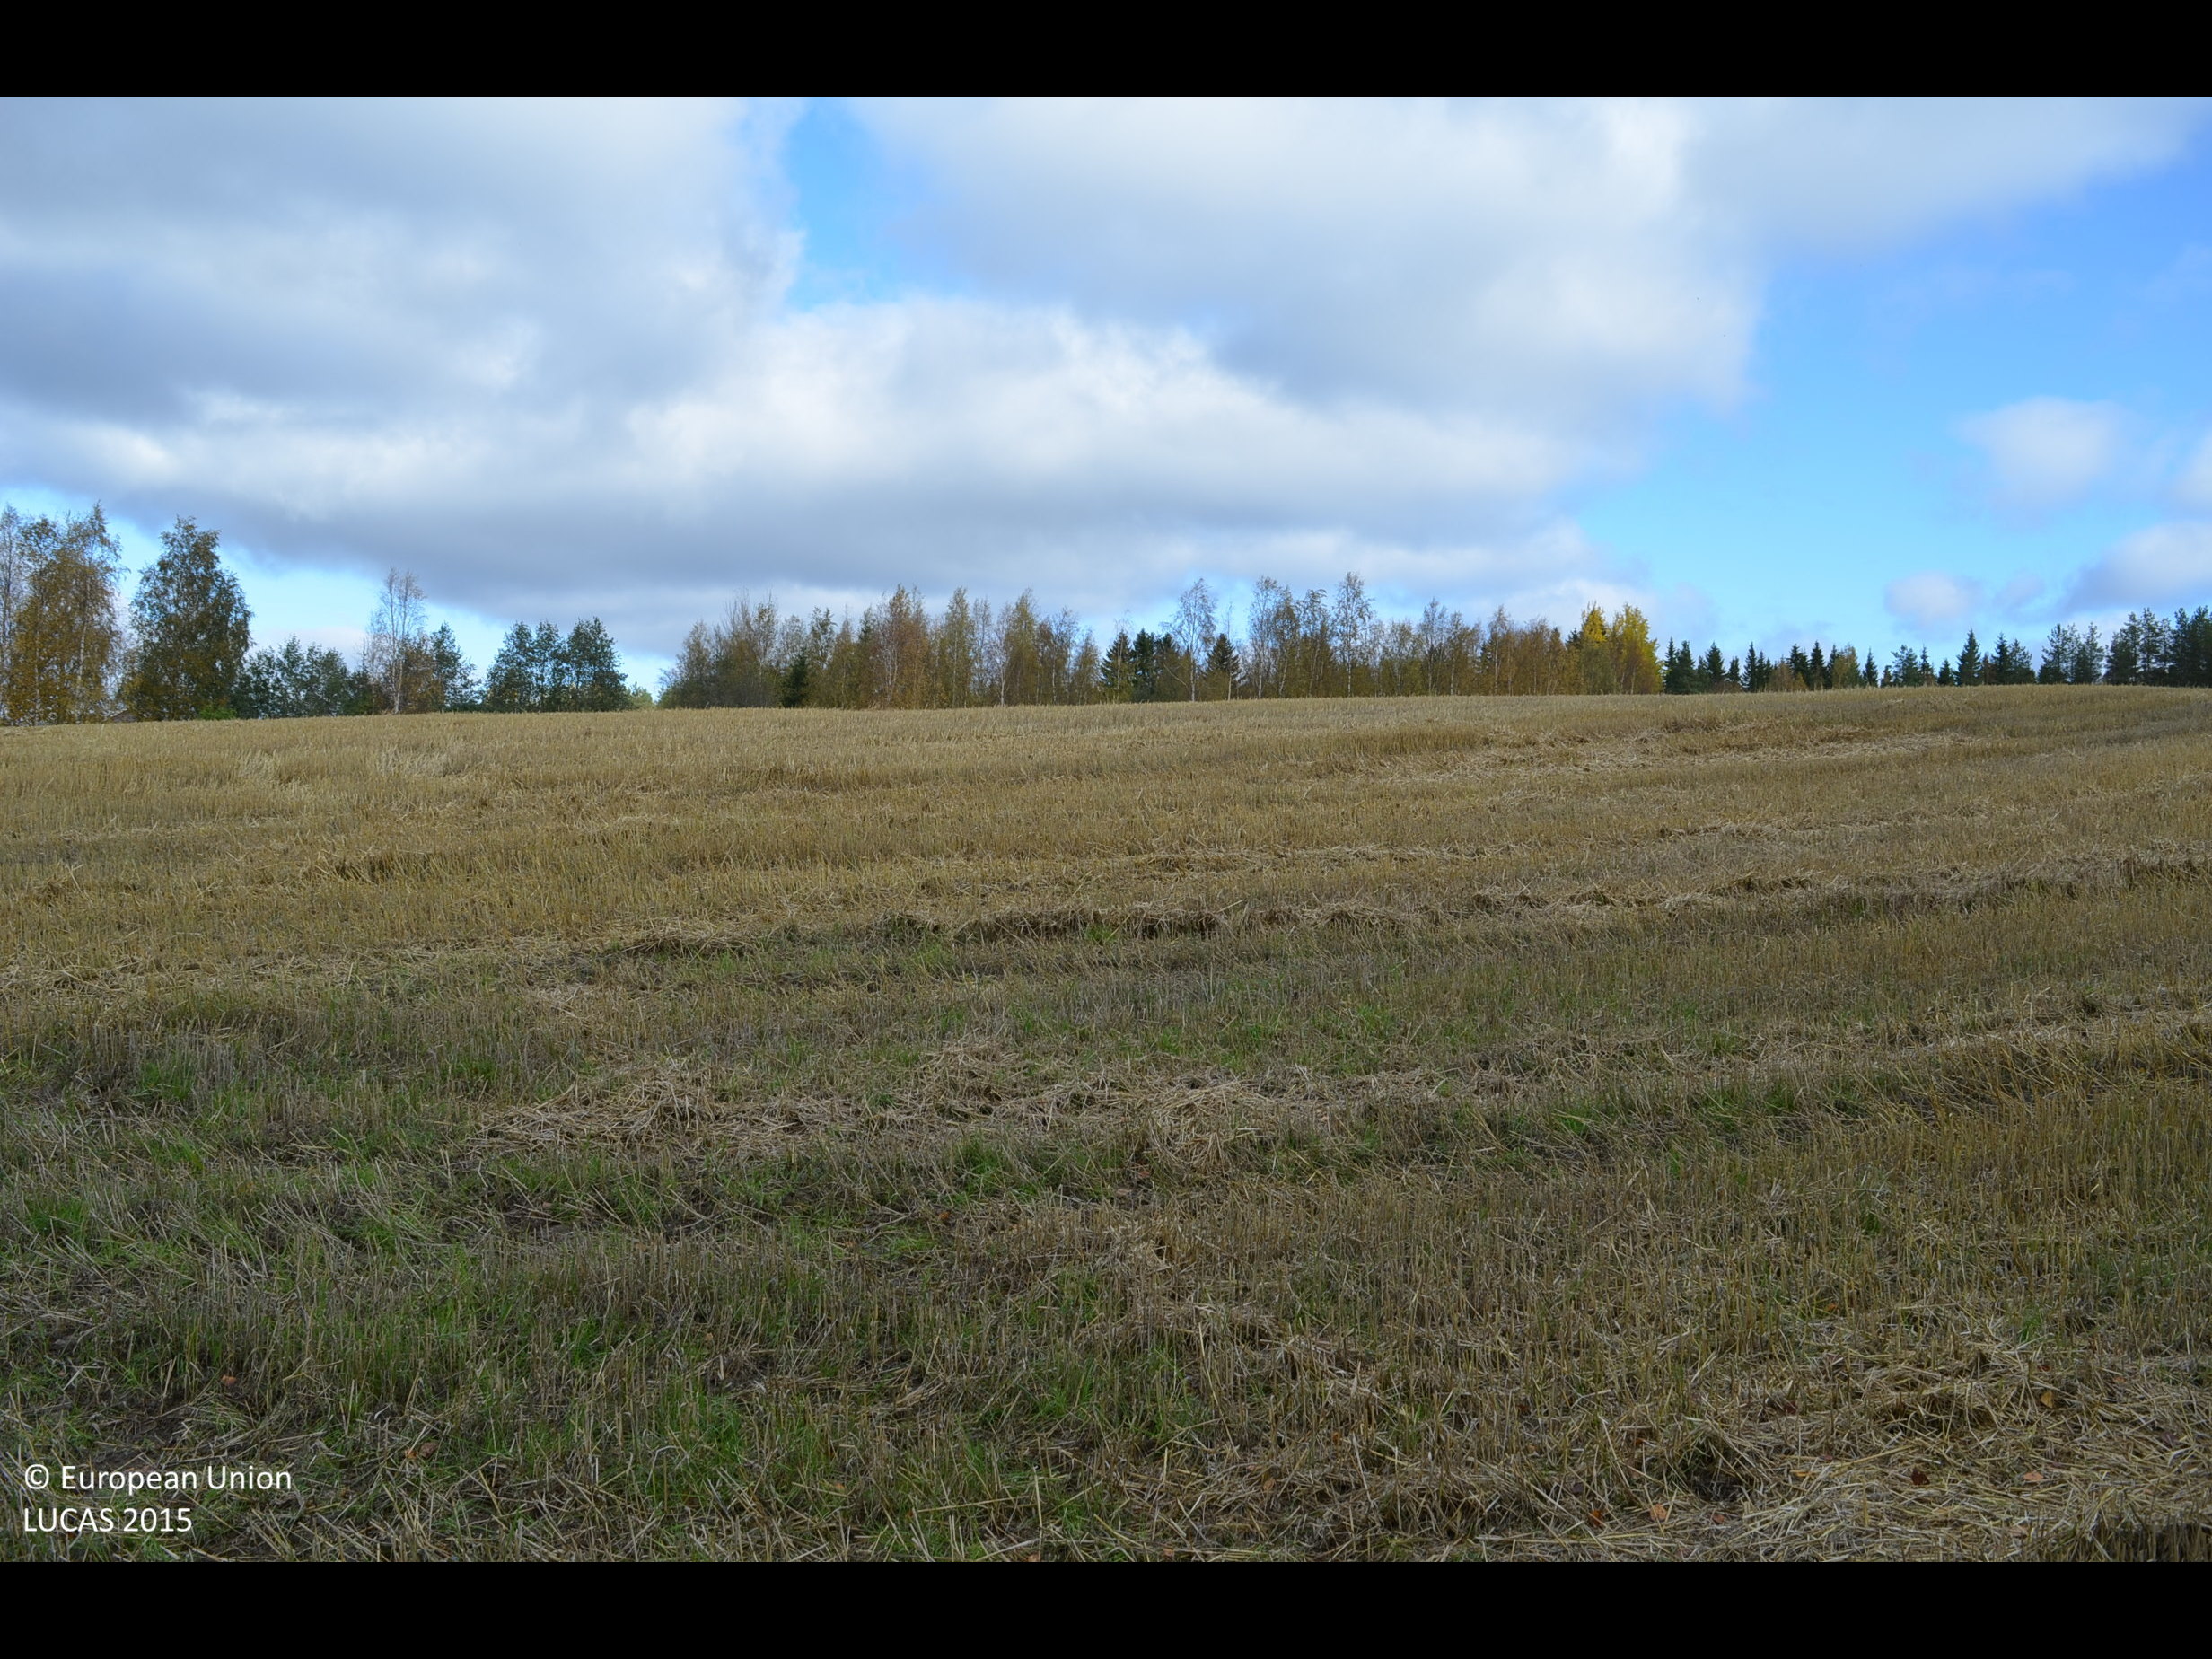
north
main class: Cropland
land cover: Barley
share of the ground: > 75 %
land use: Agriculture (excluding fallow land and kitchen gardens)
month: September
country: FI
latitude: 62.5753
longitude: 23.6375
